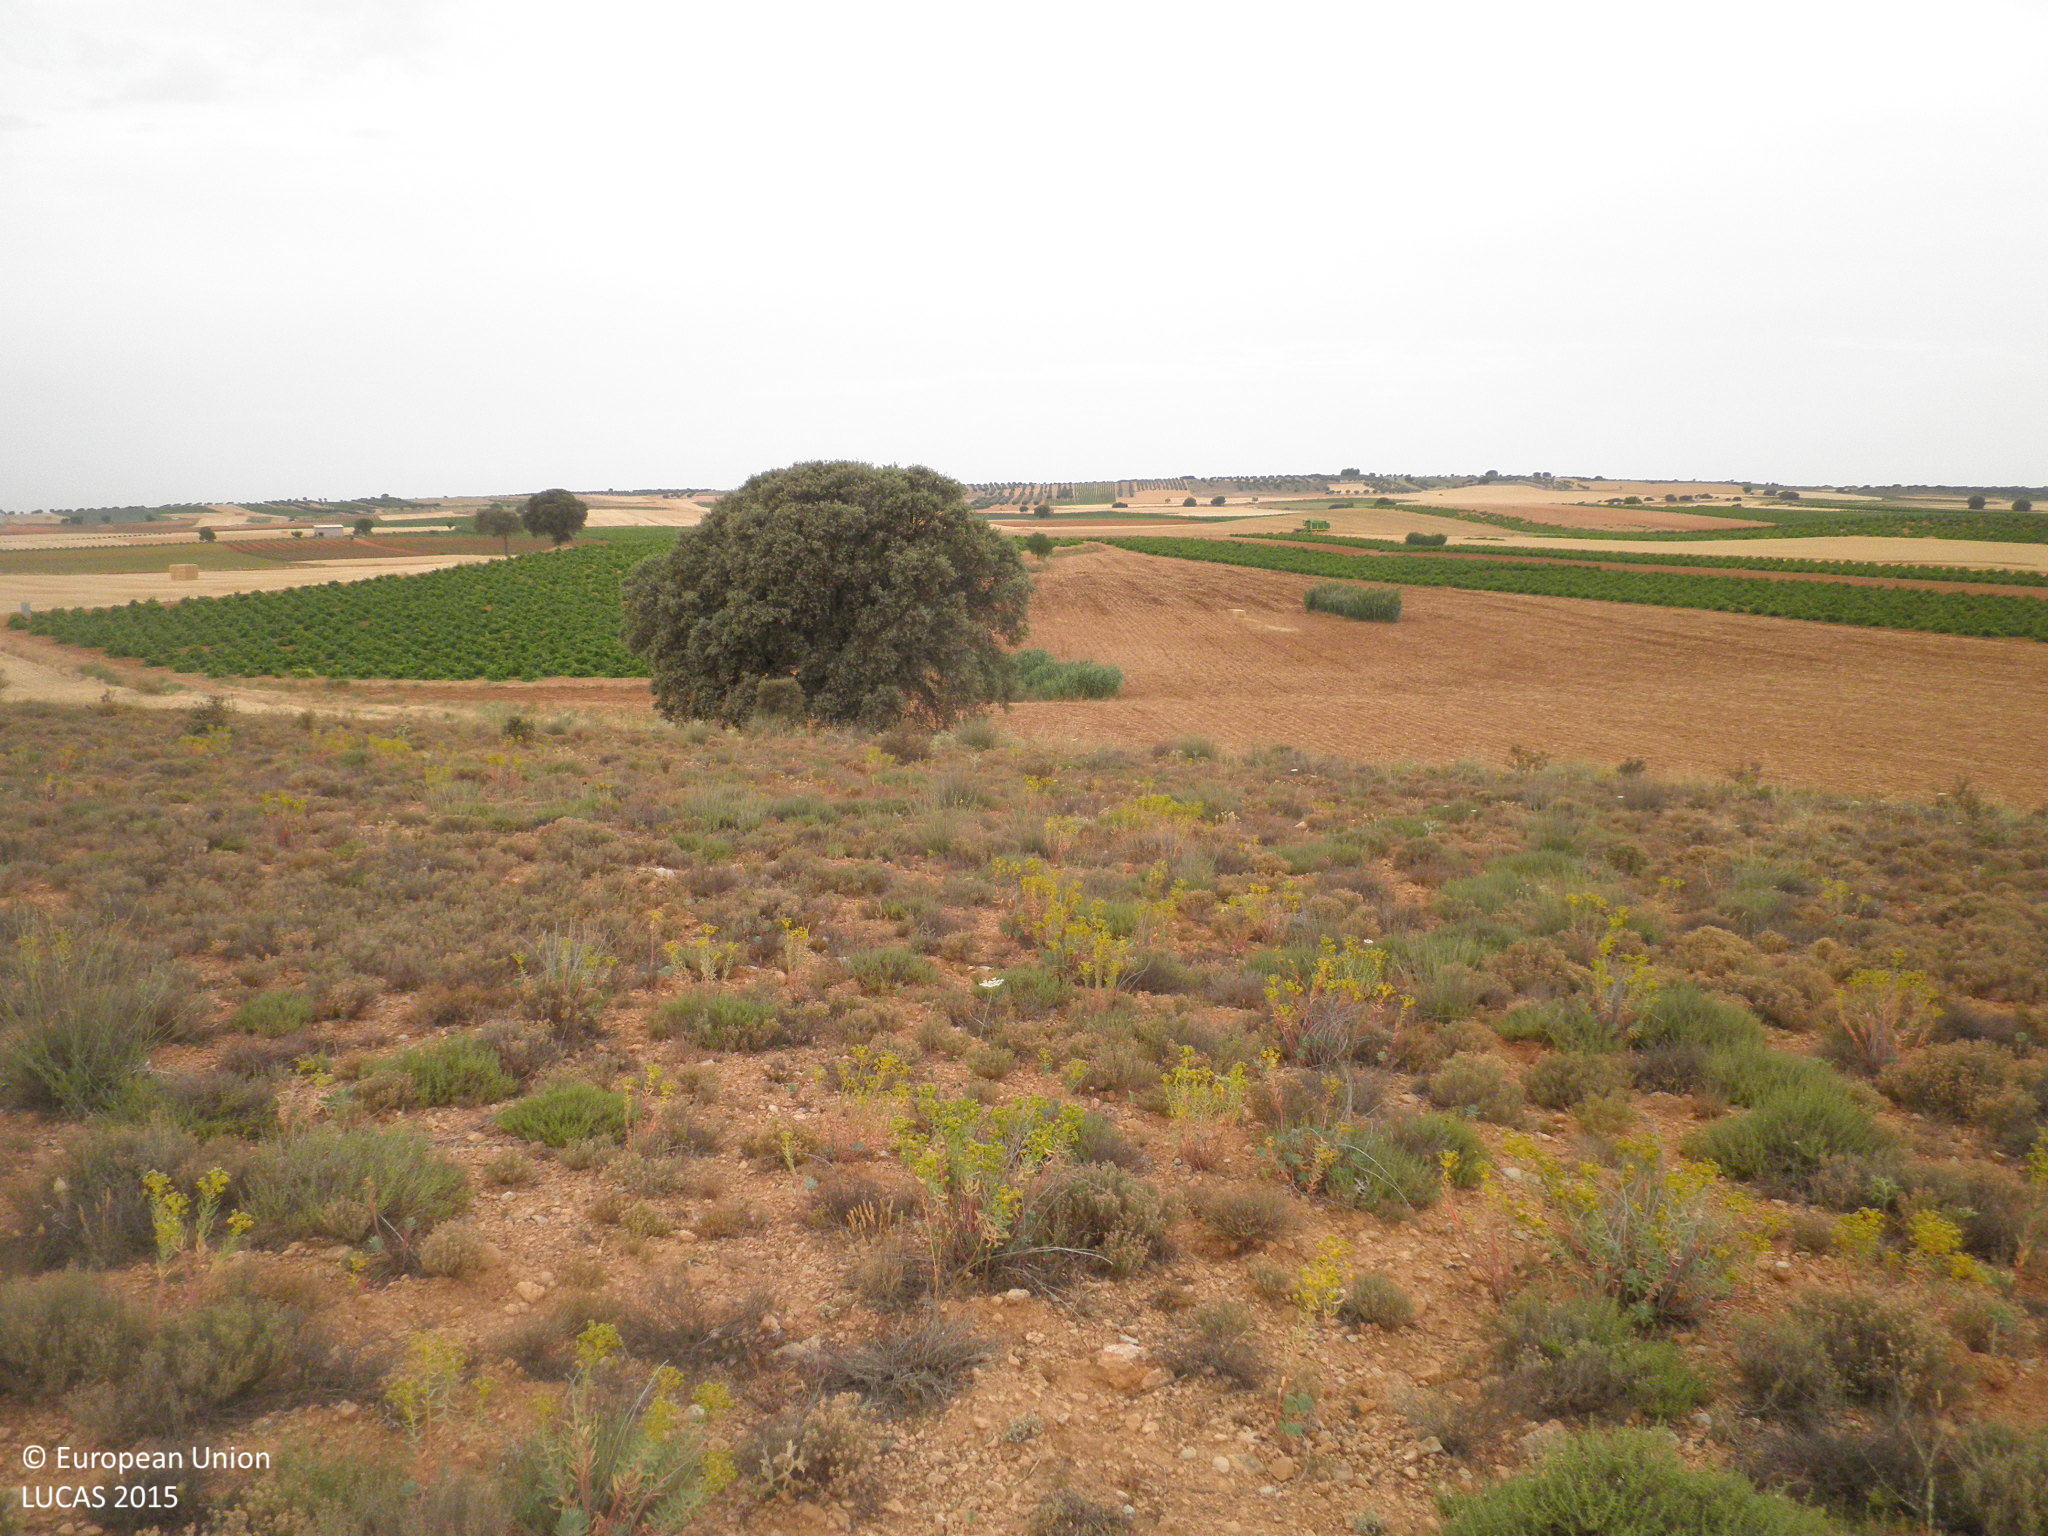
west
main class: Shrubland
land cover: Shrubland without tree cover
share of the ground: 50 - 75 %
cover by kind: shrubs 60 %, unconsolidated bare surface 35 %, herbaceous plants 5 %
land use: Semi-natural and natural areas not in use
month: July
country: ES
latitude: 39.5053
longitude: -2.6083
